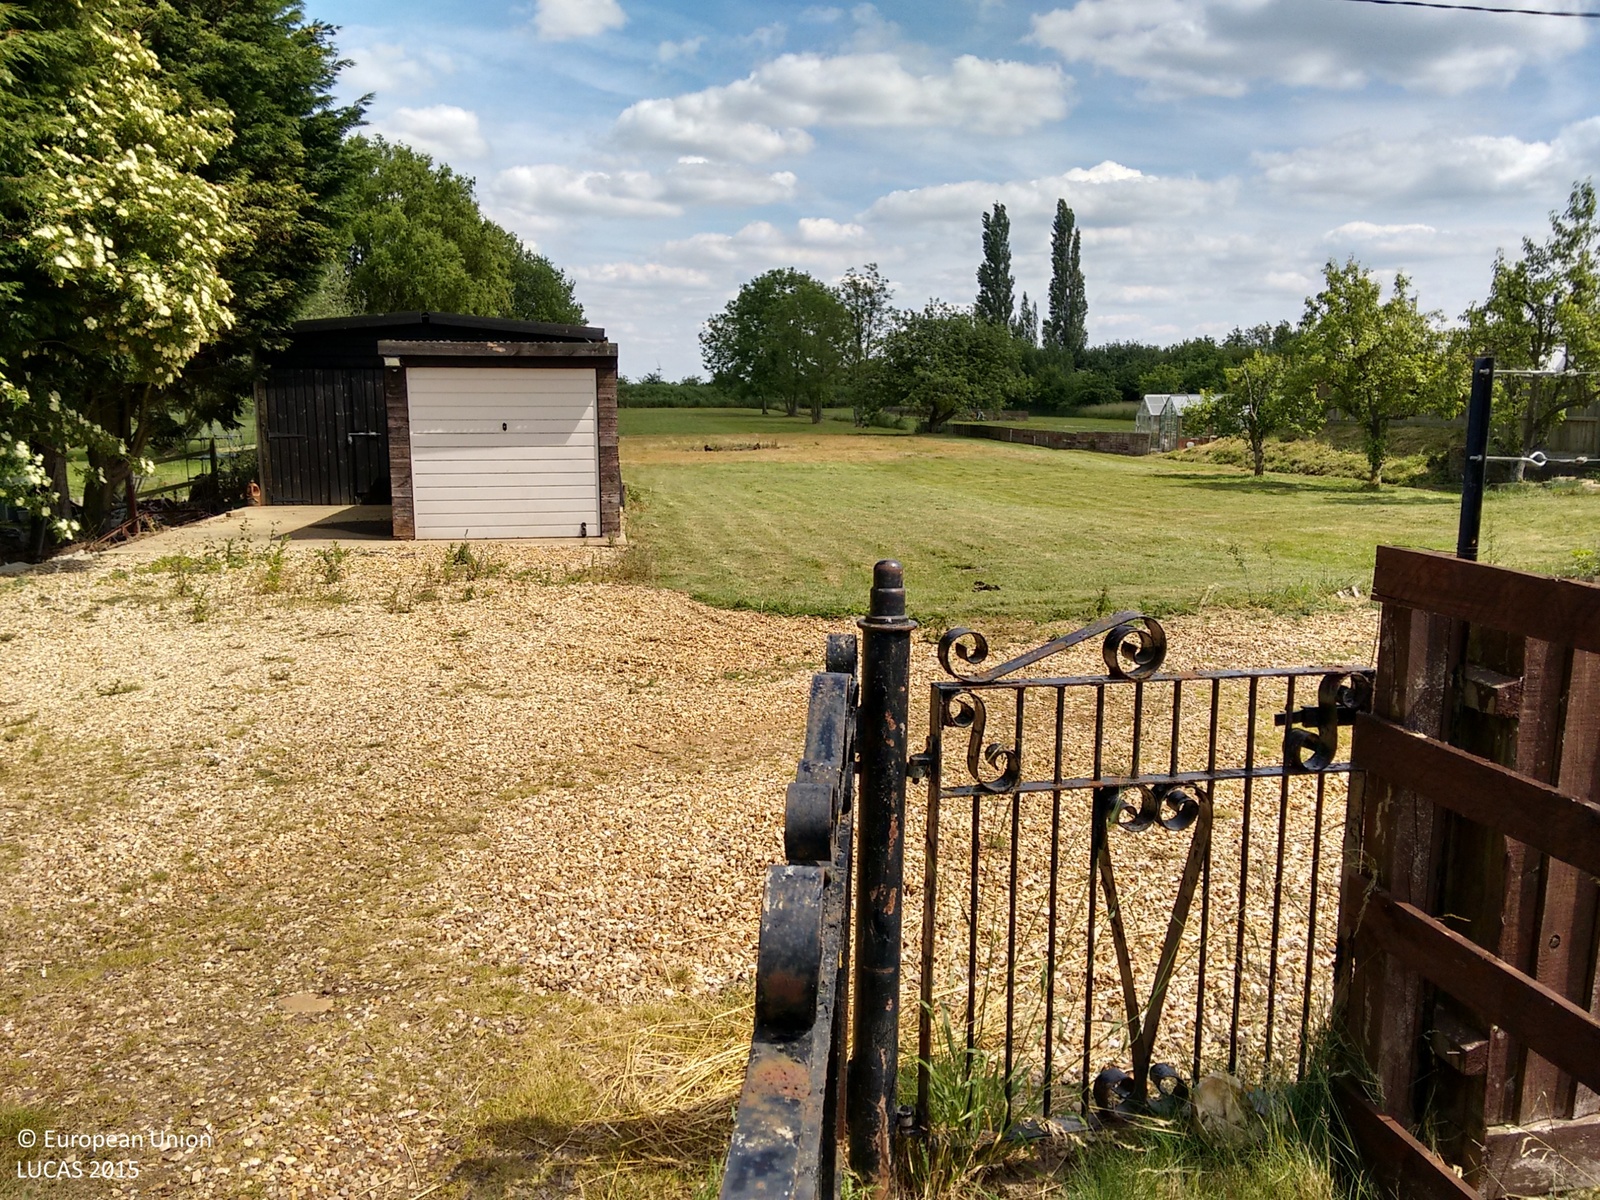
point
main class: Grassland
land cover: Grassland without tree/shrub cover
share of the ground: > 75 %
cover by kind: herbaceous plants 100 %
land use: Residential
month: June
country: GB
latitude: 52.5783
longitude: 0.0960
